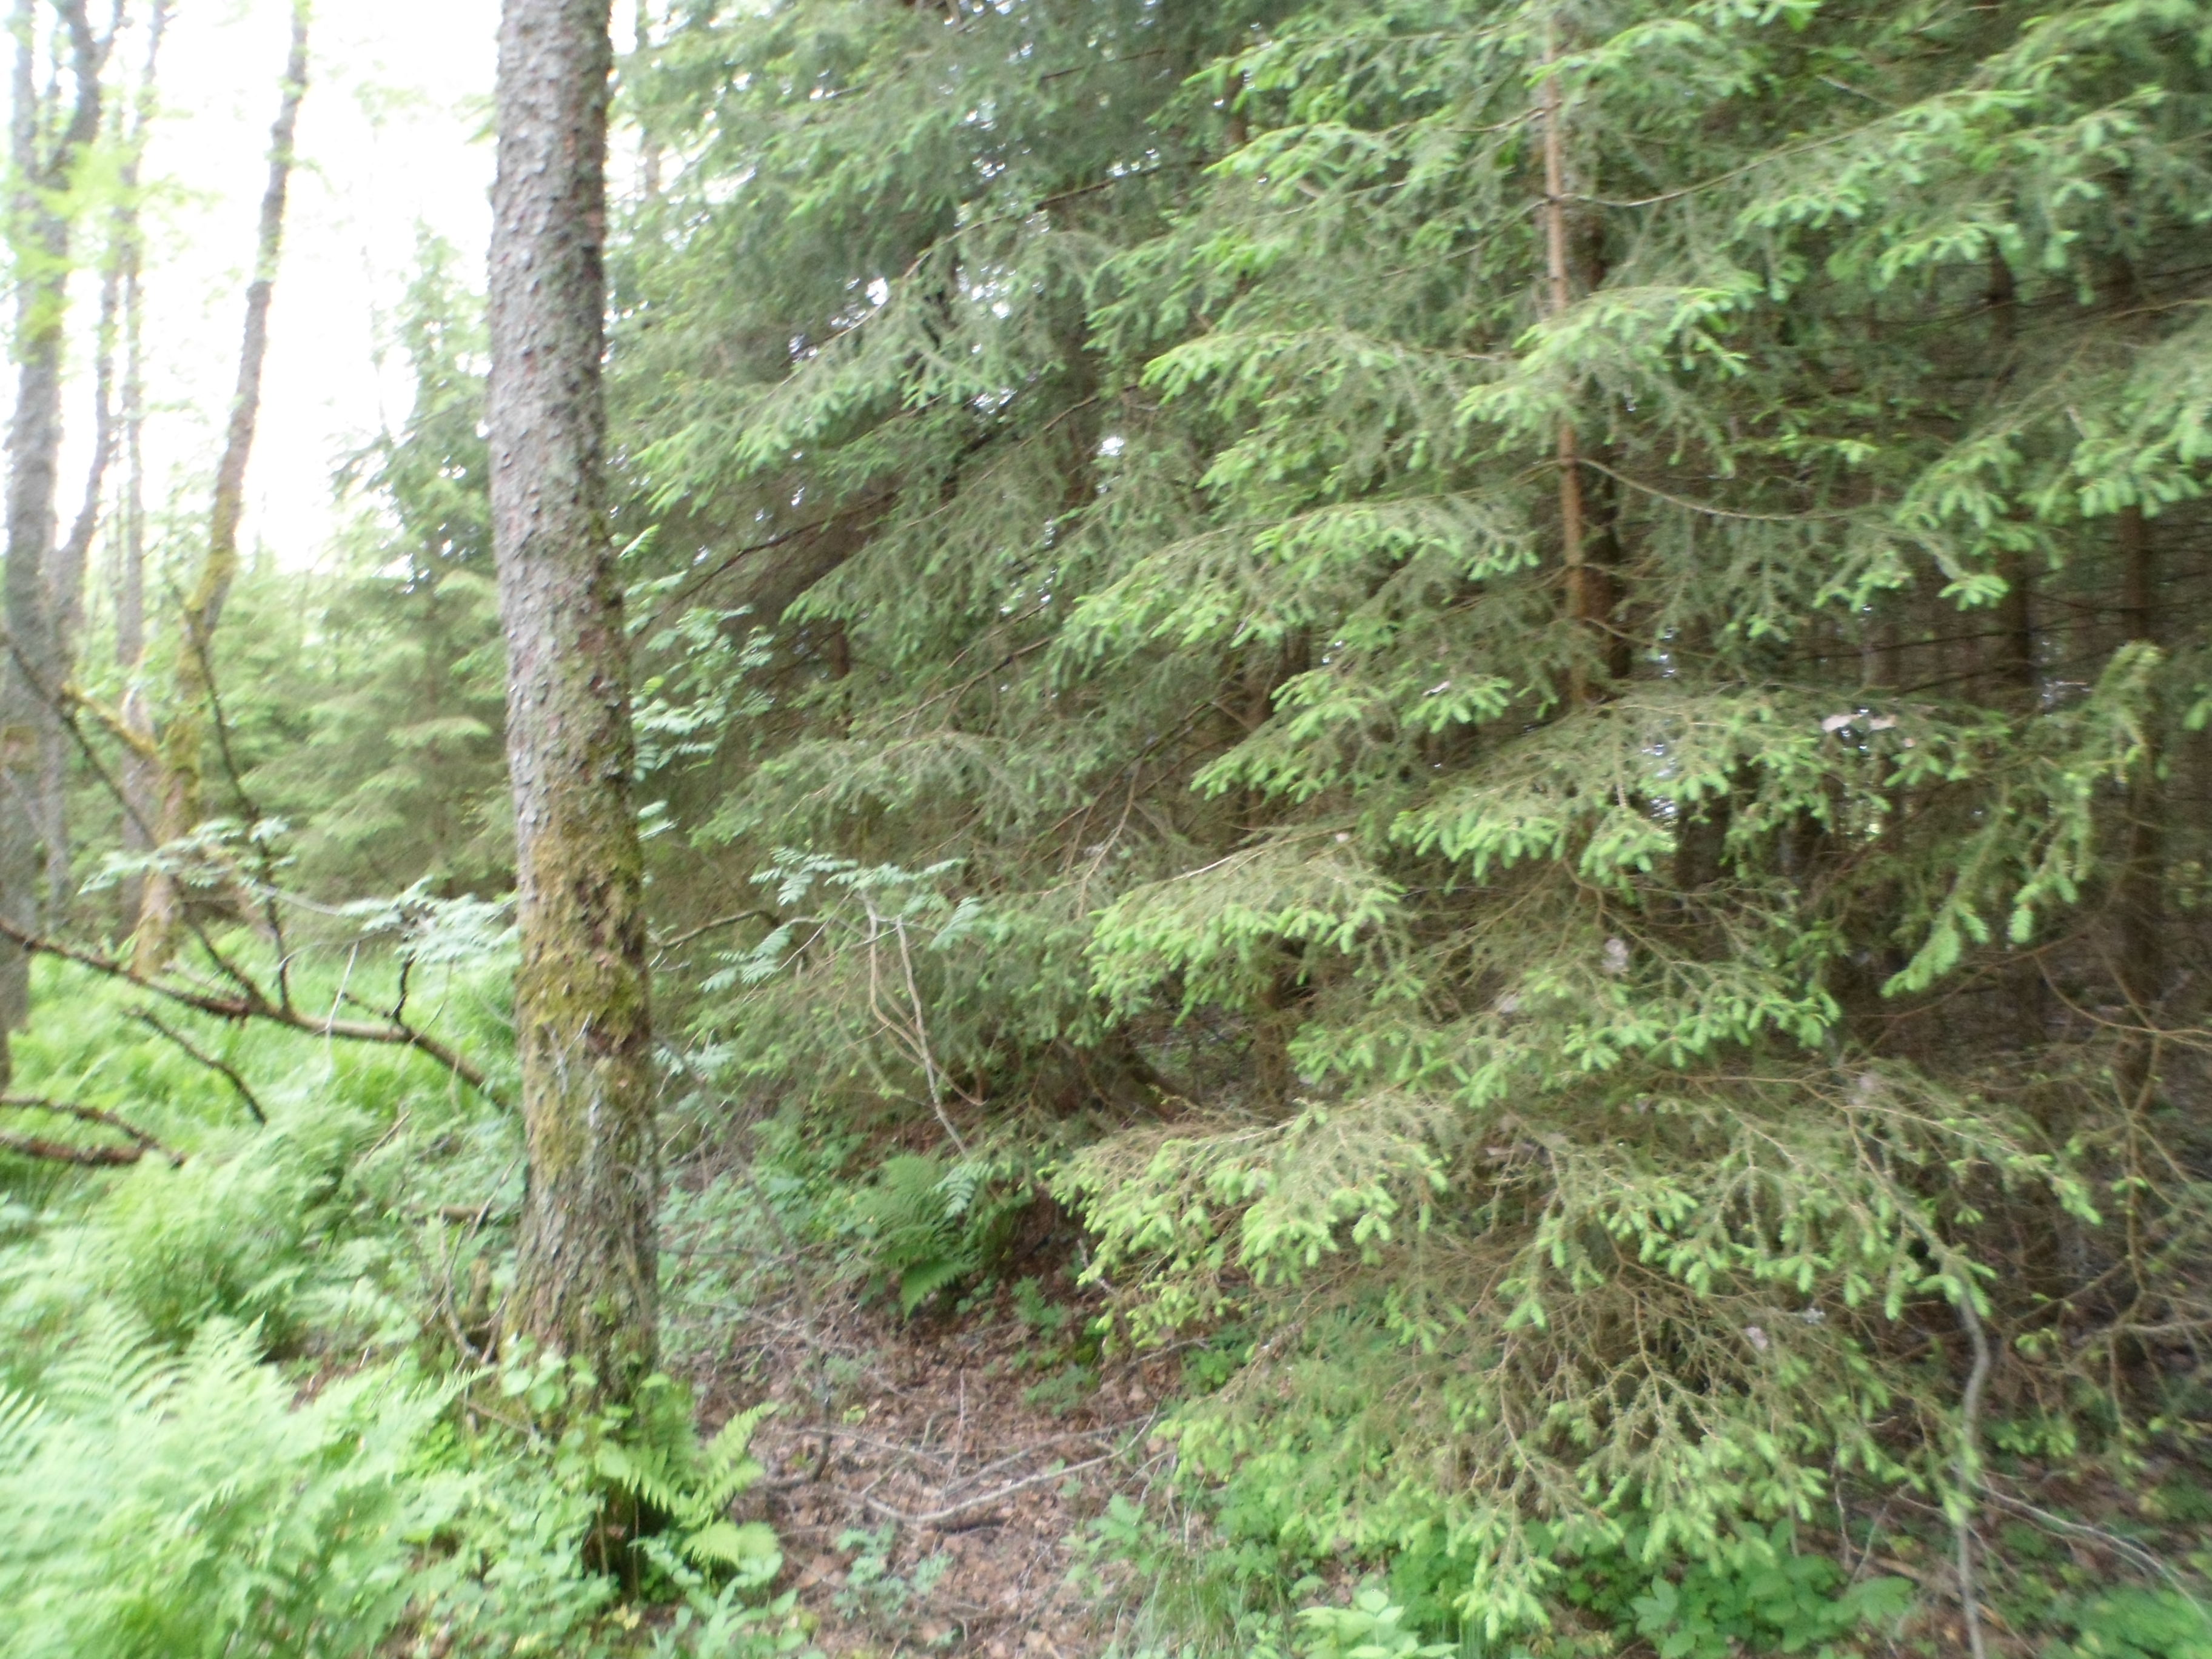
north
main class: Woodland
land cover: Spruce dominated mixed woodland
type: boreal forest
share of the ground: 50 - 75 %
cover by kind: broadleaved forest trees 45 %, coniferous forest trees 30 %, herbaceous plants 15 %, shrubs 5 %, lichens and mosses 5 %
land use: Forestry
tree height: > 5 m
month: June
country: SE
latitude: 56.9547
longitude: 14.5184
